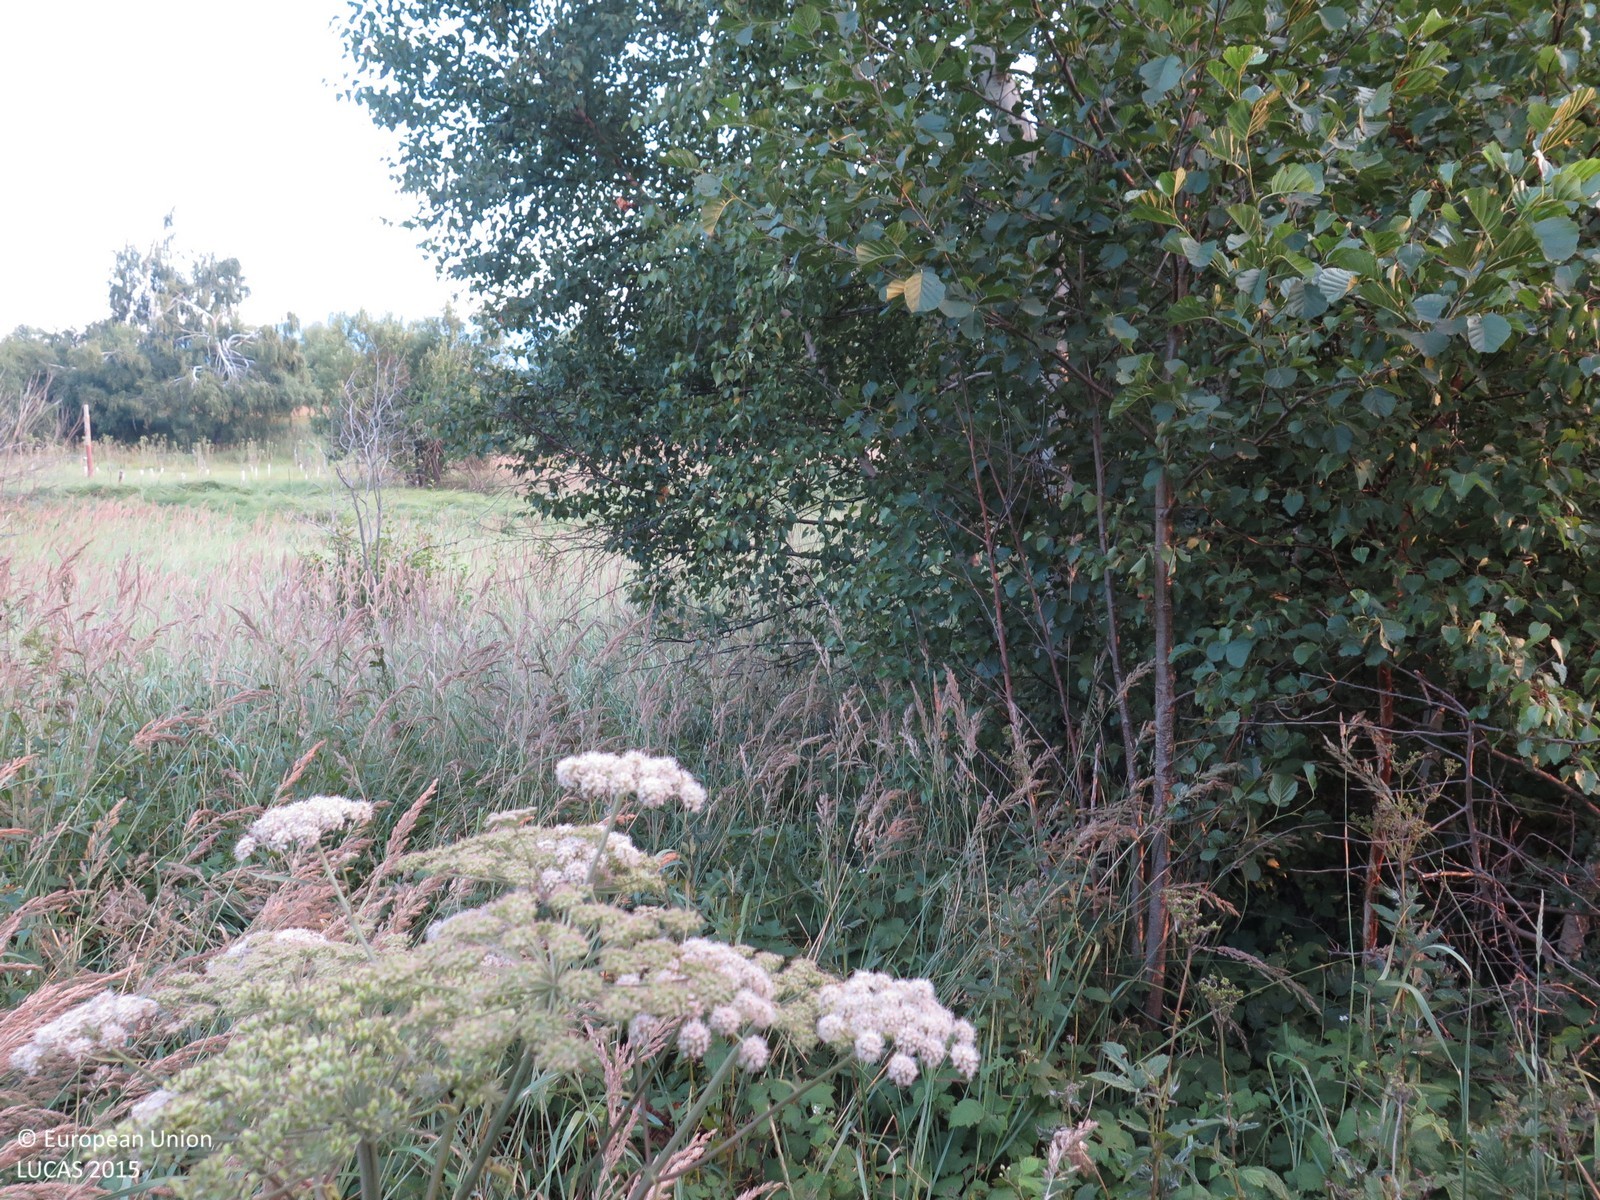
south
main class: Shrubland
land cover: Shrubland with sparse tree cover
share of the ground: > 75 %
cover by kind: shrubs 90 %, broadleaved forest trees 5 %, herbaceous plants 5 %
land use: Semi-natural and natural areas not in use
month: August
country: HR
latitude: 45.2903
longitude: 14.7254
